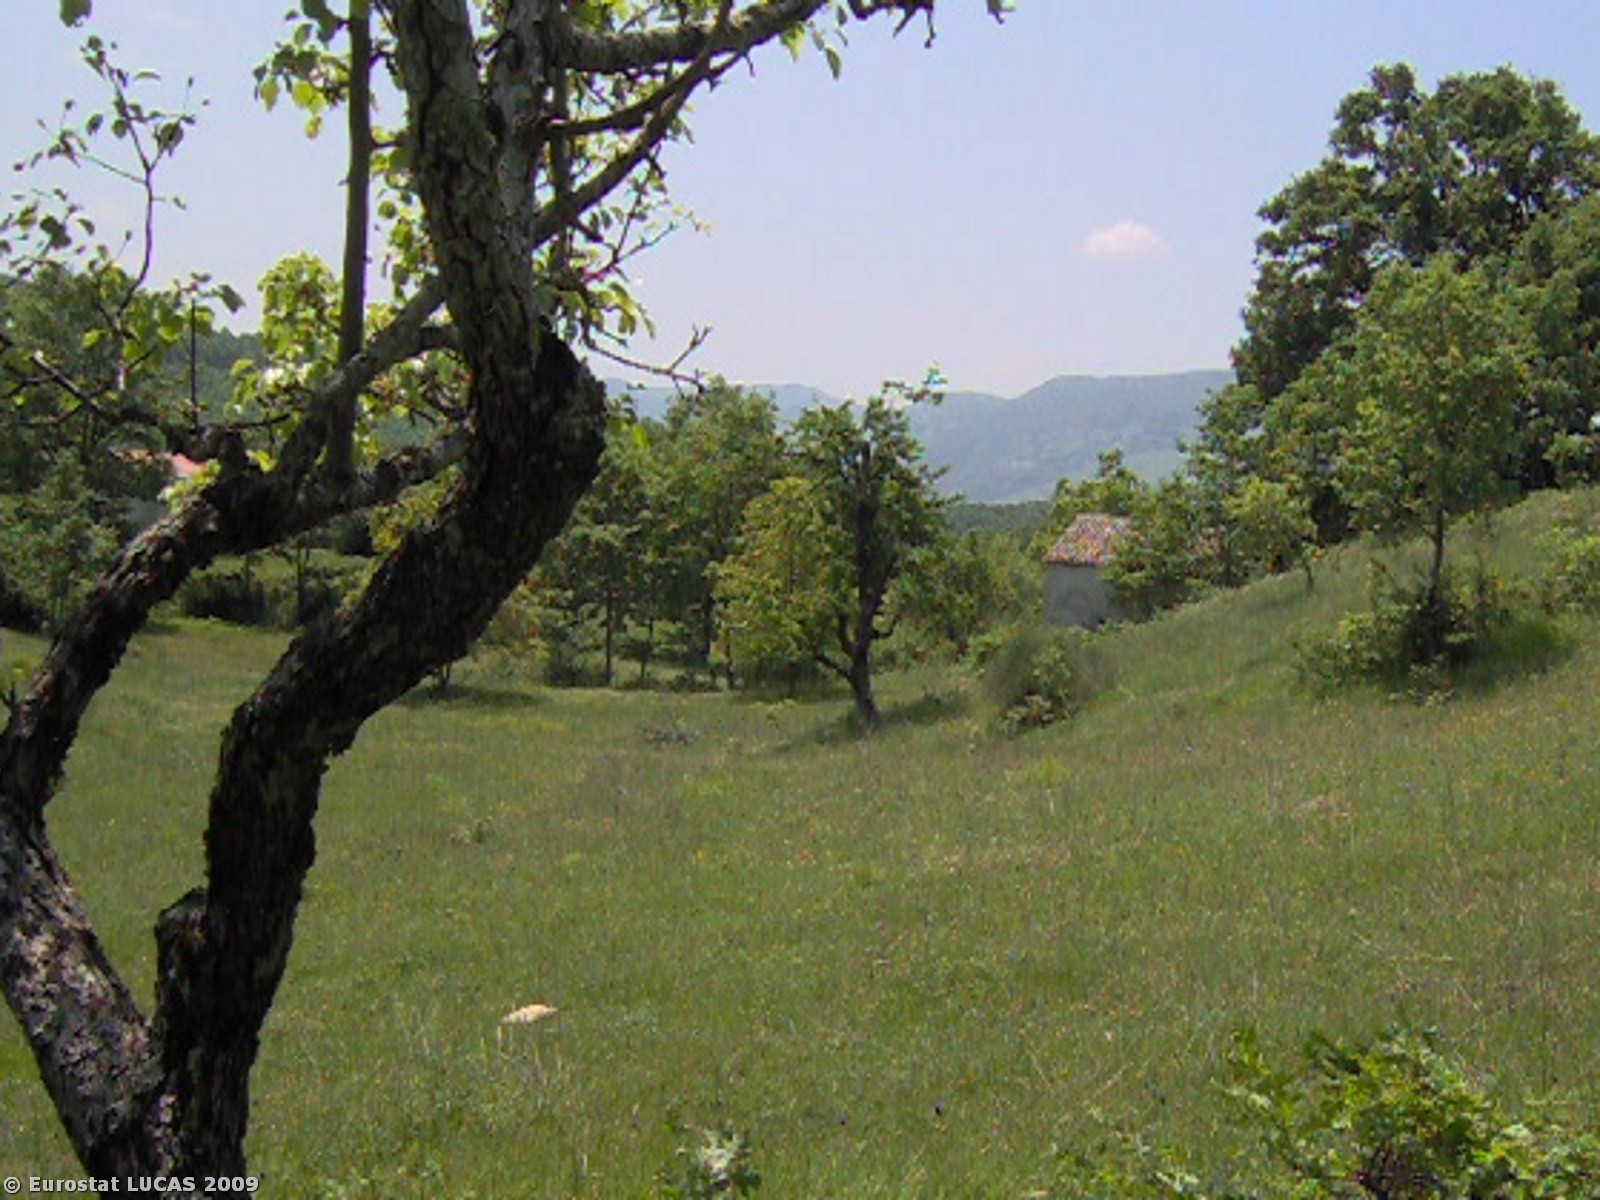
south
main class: Cropland
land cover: Mixed cereals for fodder
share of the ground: > 75 %
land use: Agriculture (excluding fallow land and kitchen gardens)
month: May
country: IT
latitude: 40.5808
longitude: 15.5658
